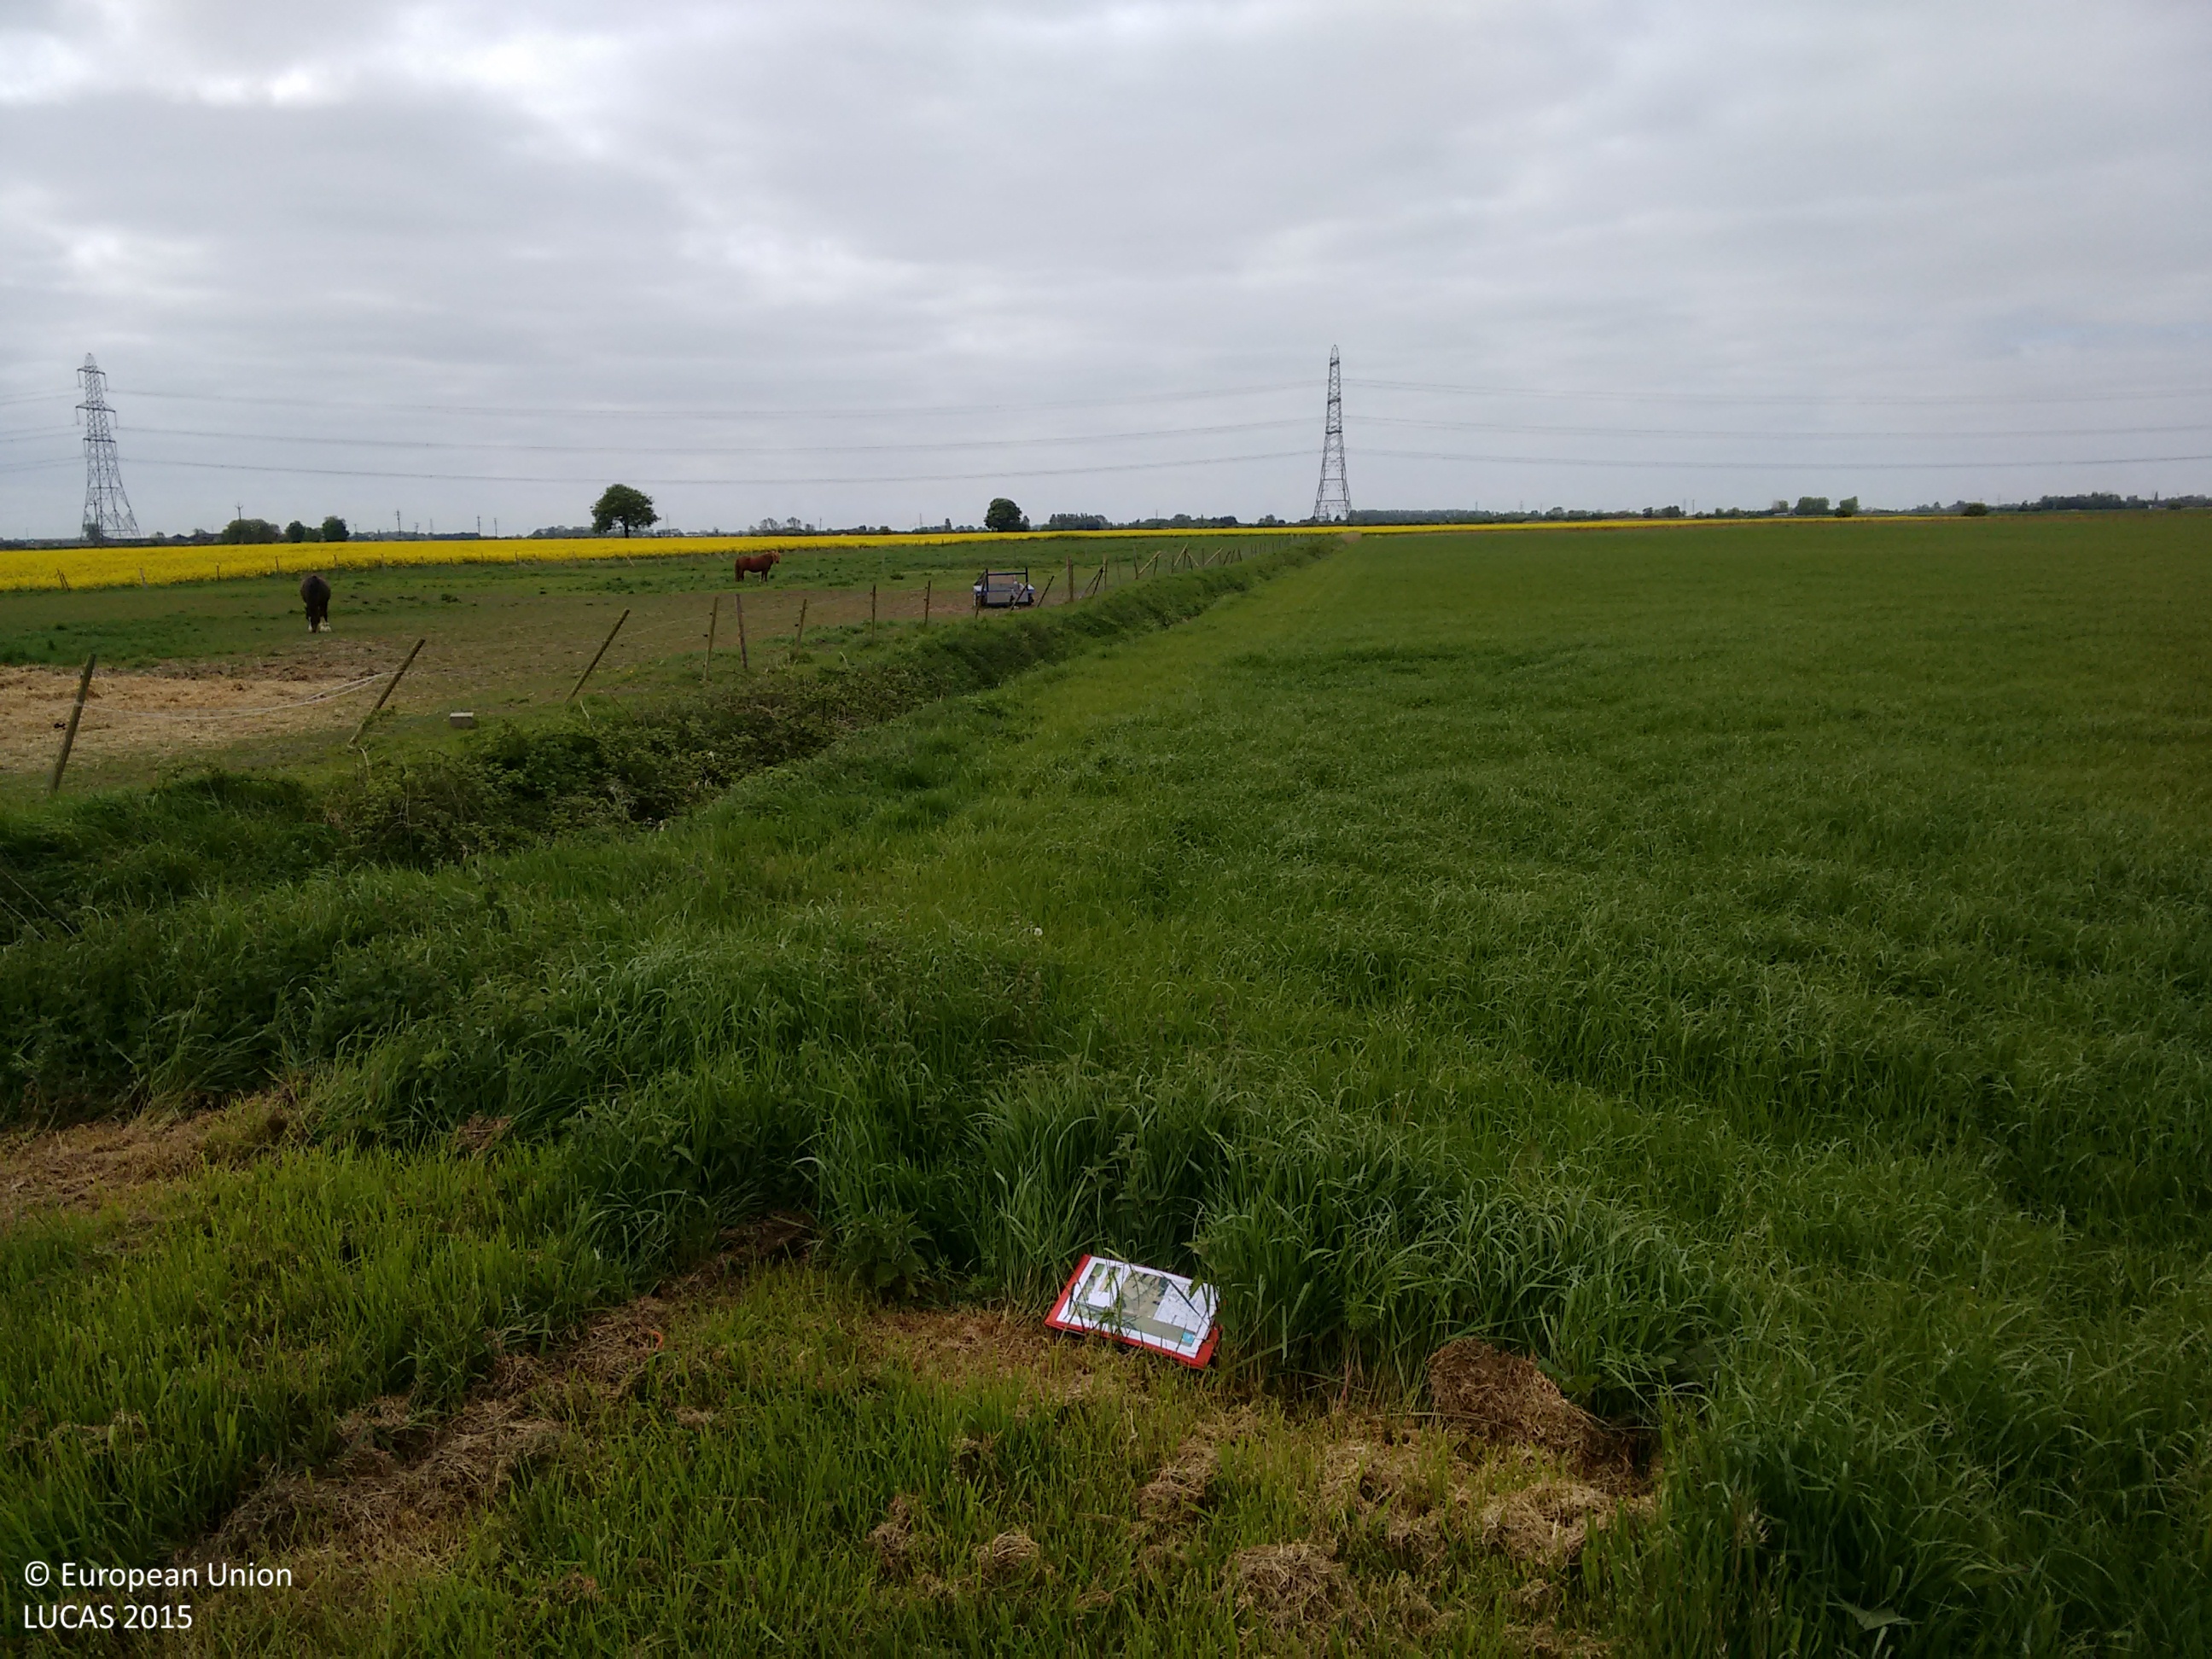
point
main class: Grassland
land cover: Grassland without tree/shrub cover
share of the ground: > 75 %
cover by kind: herbaceous plants 100 %
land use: Agriculture (excluding fallow land and kitchen gardens)
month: May
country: GB
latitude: 52.7739
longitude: 0.0515
